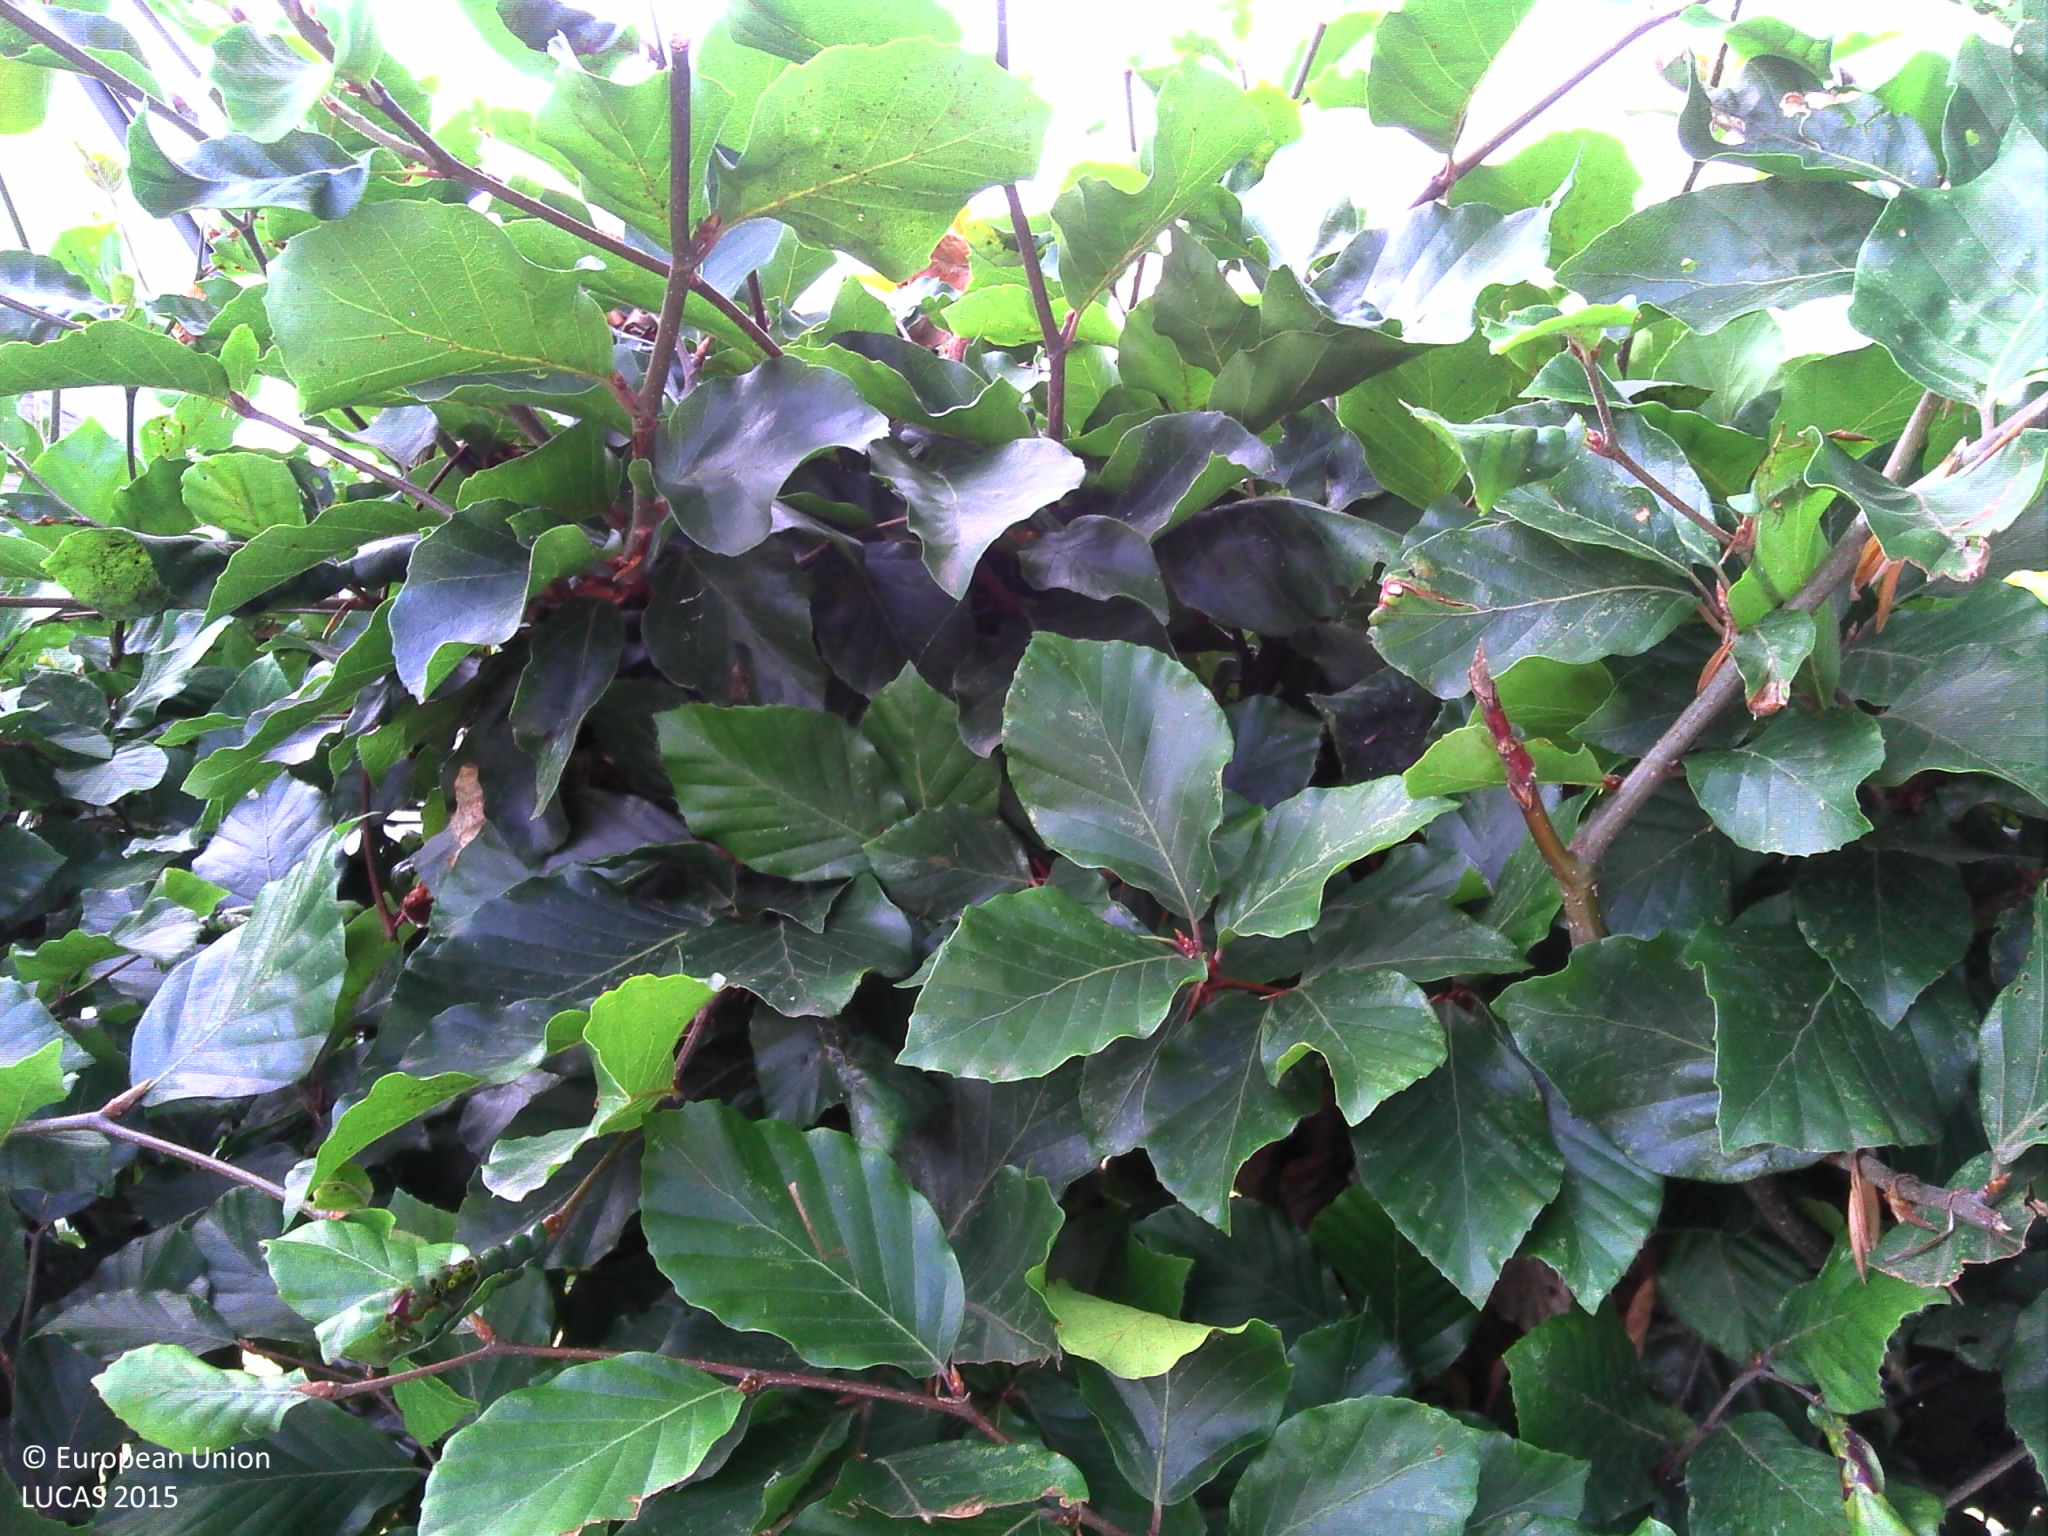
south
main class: Grassland
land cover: Grassland without tree/shrub cover
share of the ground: > 75 %
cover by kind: herbaceous plants 100 %
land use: Residential
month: July
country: BE
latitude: 49.6758
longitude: 5.8278
